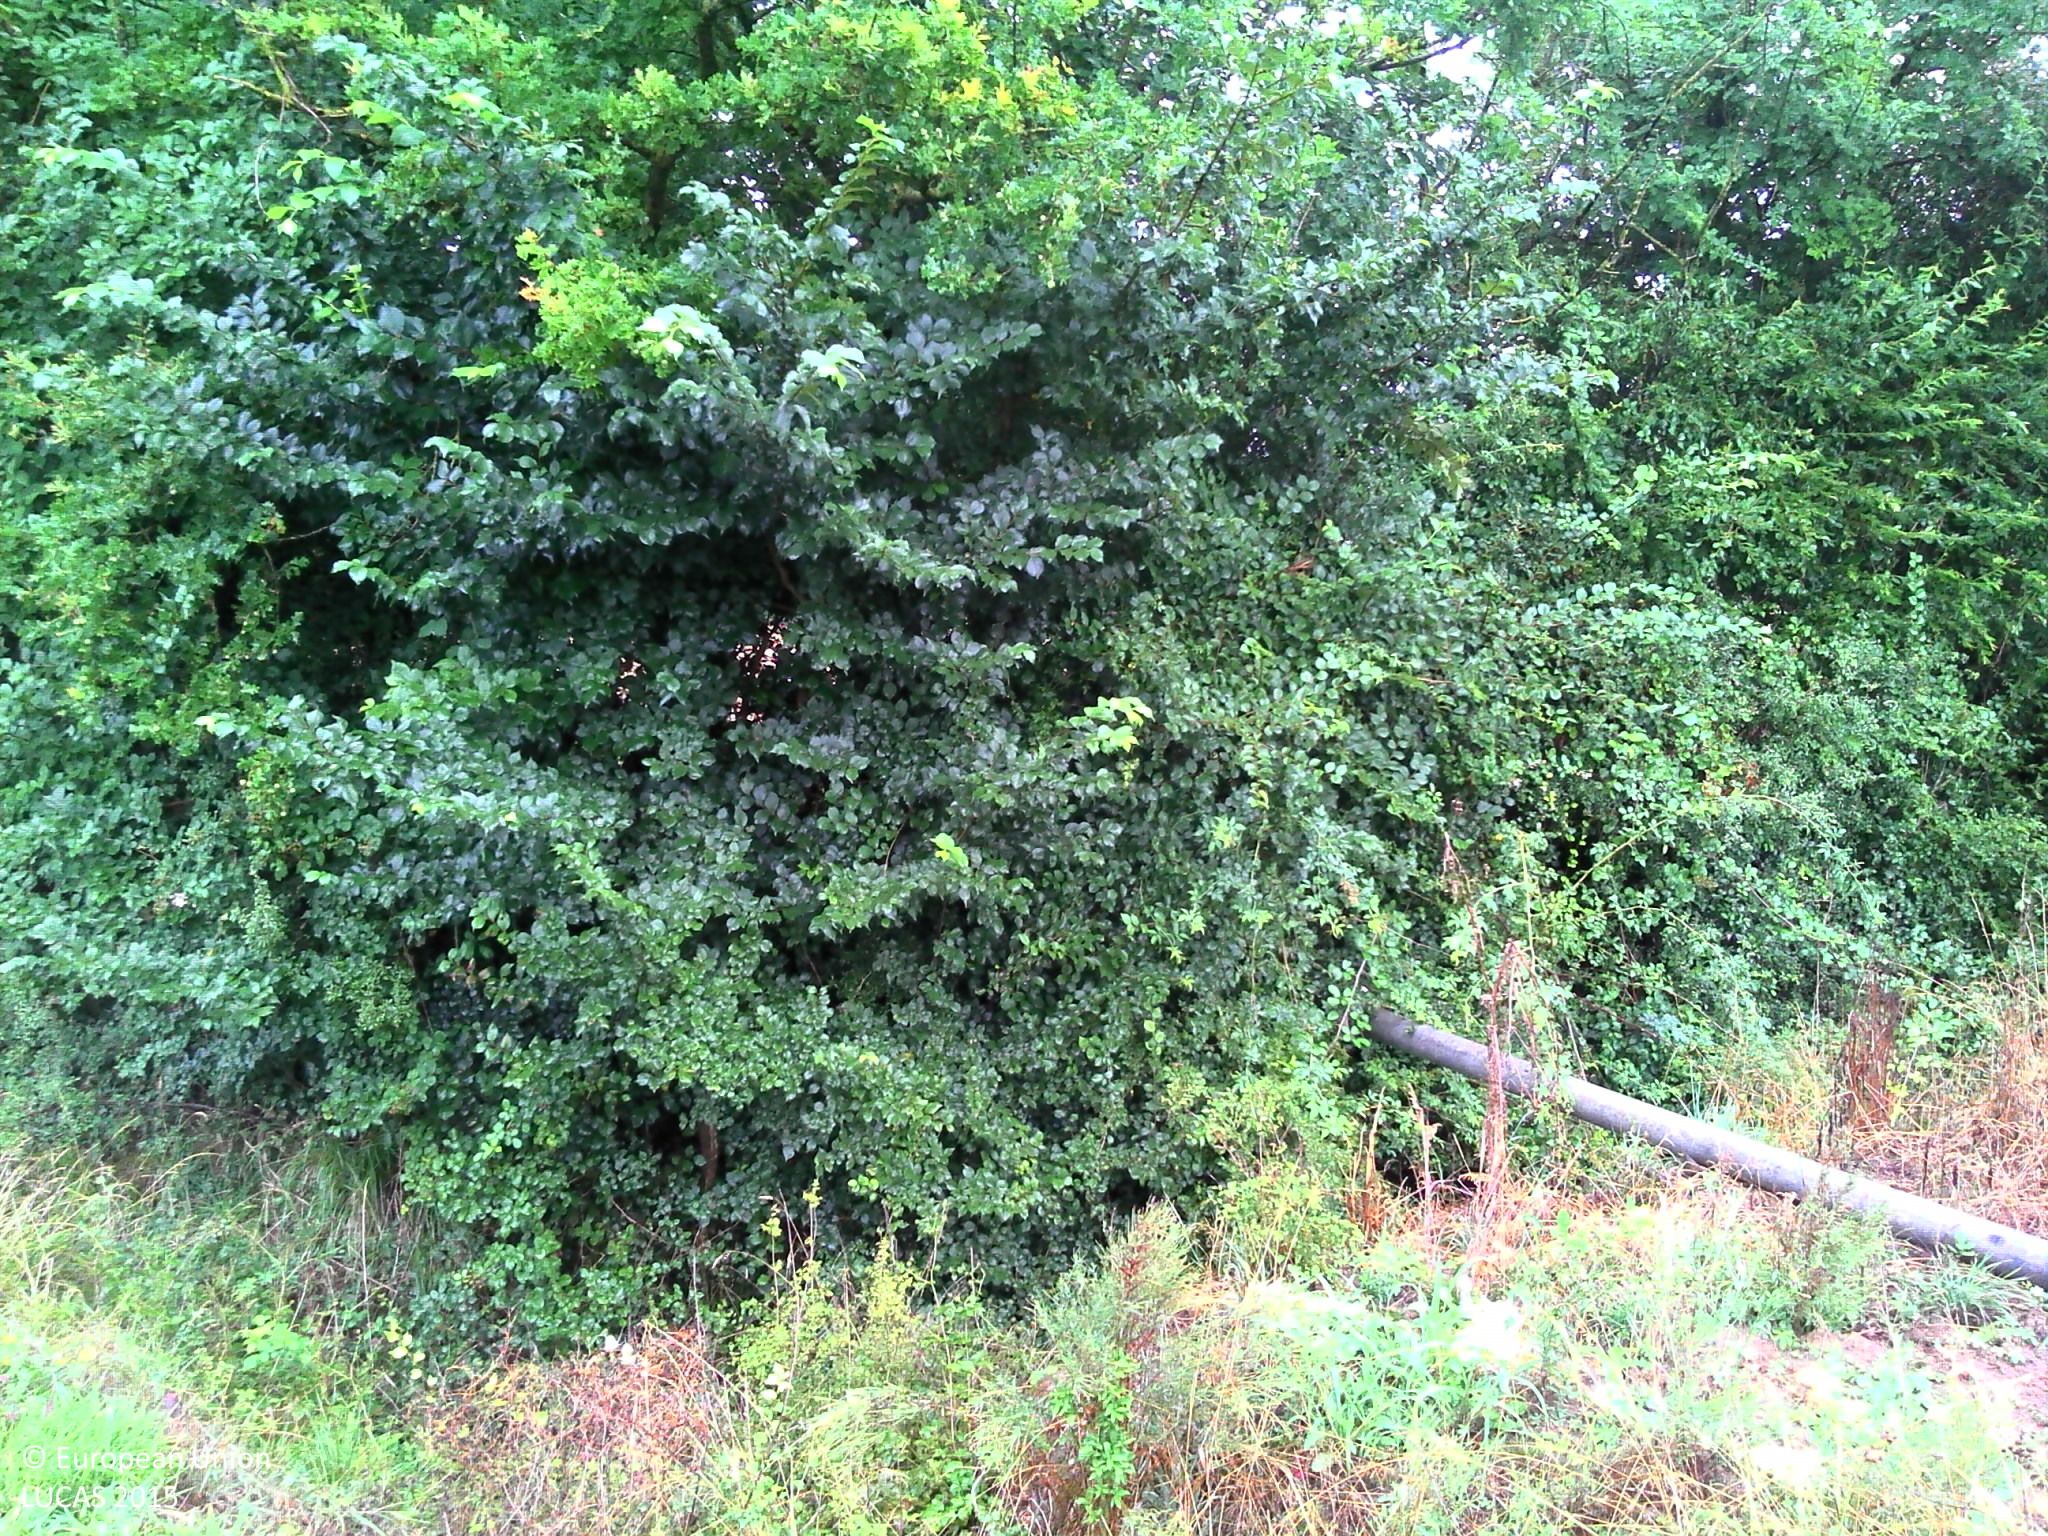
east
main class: Cropland
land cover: Maize
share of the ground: > 75 %
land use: Agriculture (excluding fallow land and kitchen gardens)
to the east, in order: Maize; Ditches and canals; Maize; Ditches and canals; Maize
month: July
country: FR
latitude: 46.3679
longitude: 0.5594
